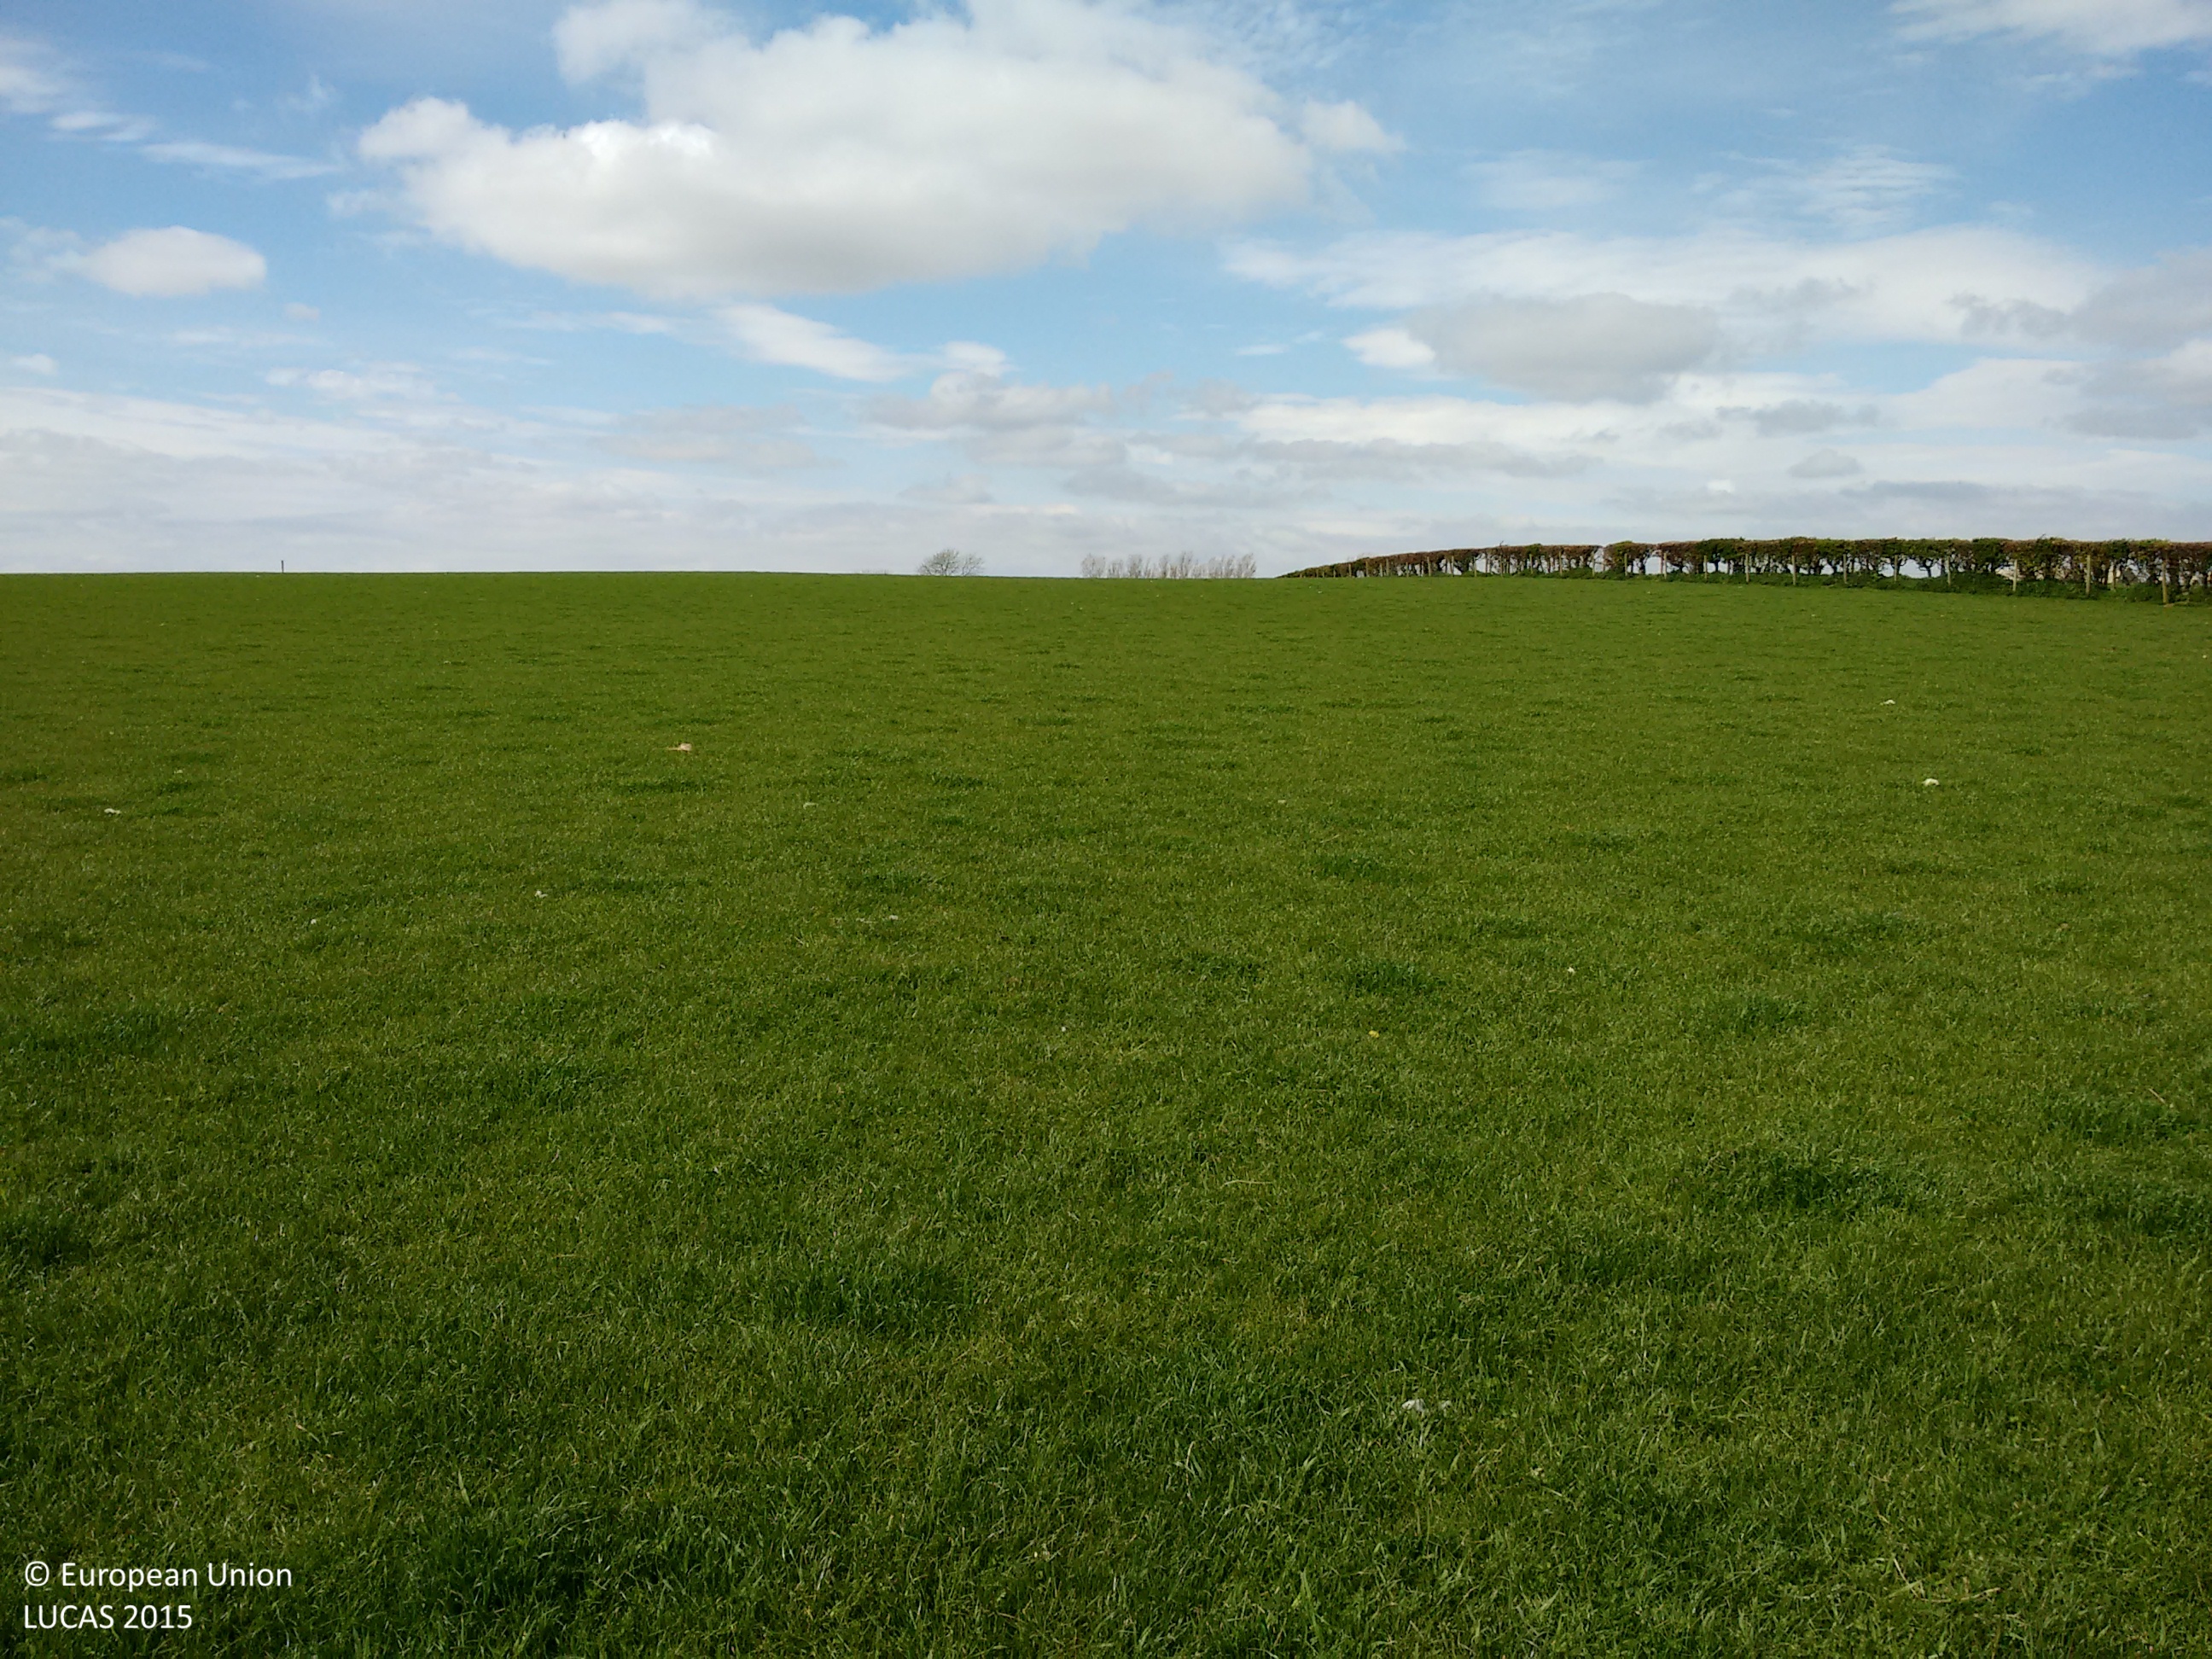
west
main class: Grassland
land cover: Grassland without tree/shrub cover
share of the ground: > 75 %
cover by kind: herbaceous plants 100 %
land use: Agriculture (excluding fallow land and kitchen gardens)
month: May
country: GB
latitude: 56.7451
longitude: -2.6323
